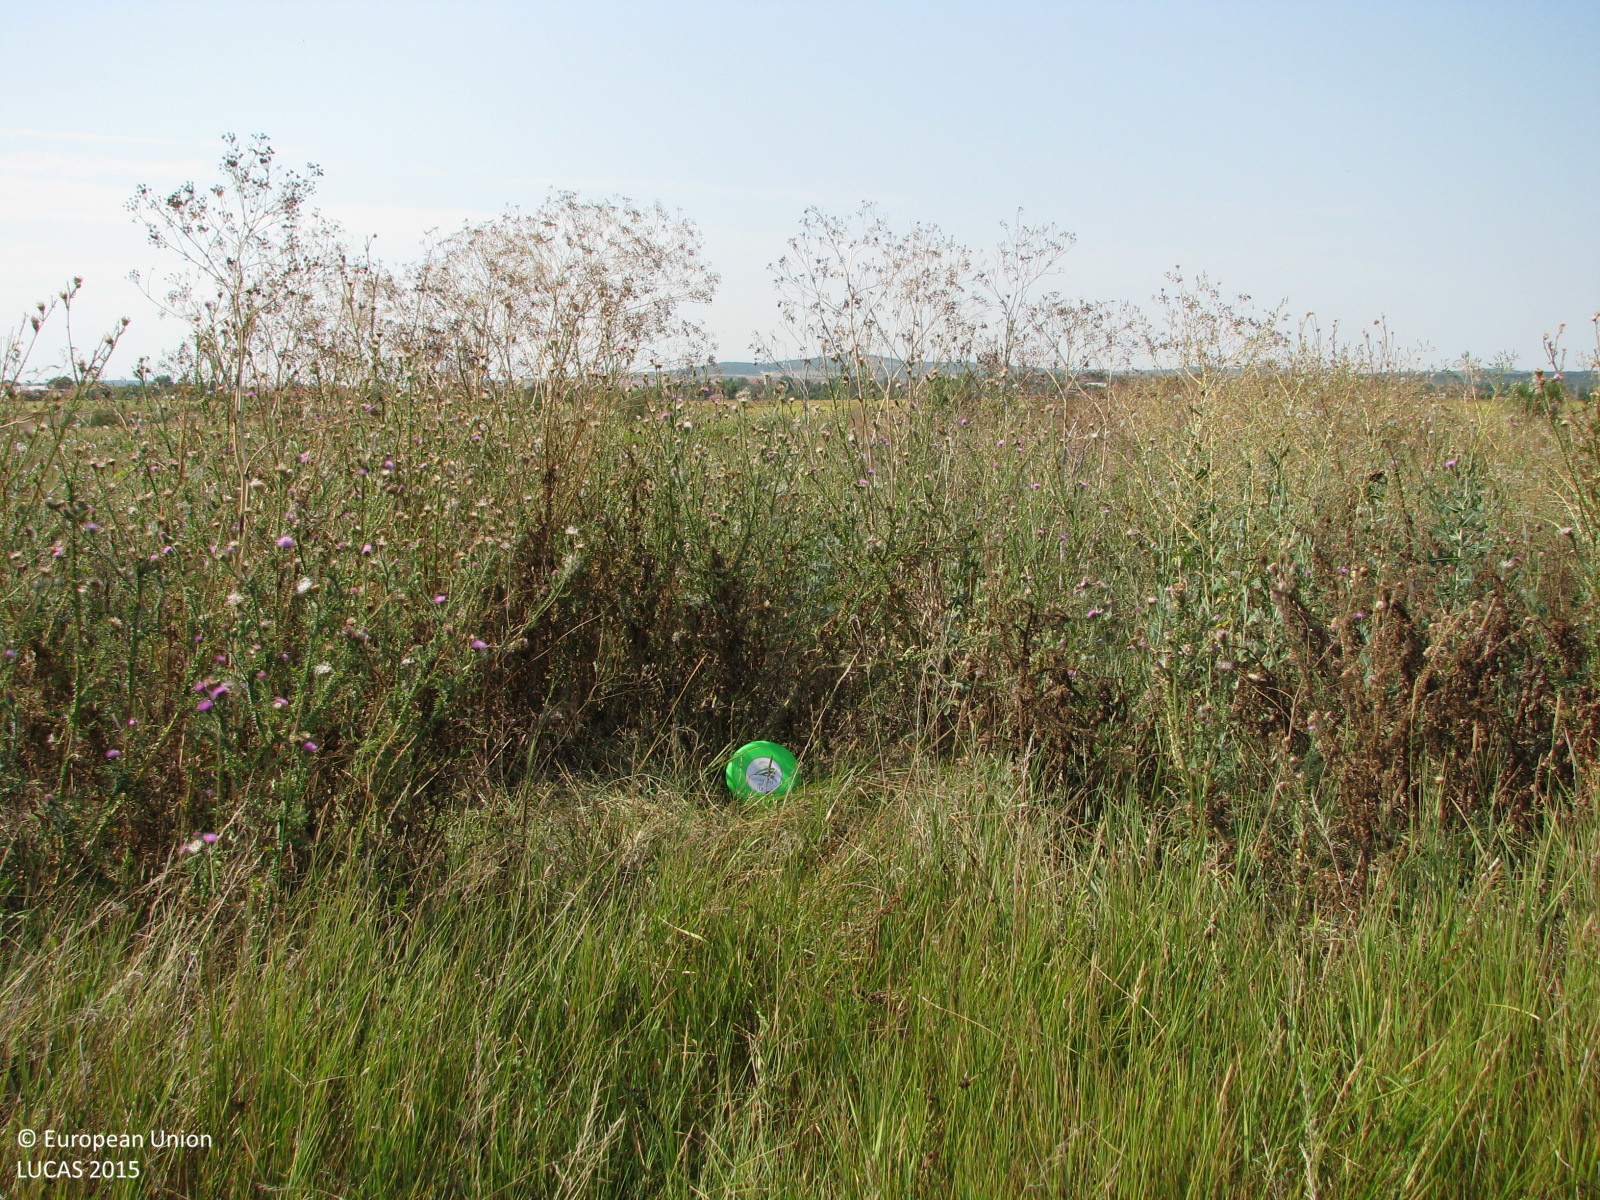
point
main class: Grassland
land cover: Grassland with sparse tree/shrub cover
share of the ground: > 75 %
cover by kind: herbaceous plants 95 %, broadleaved forest trees 5 %
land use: Semi-natural and natural areas not in use
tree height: > 5 m
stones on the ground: < 10 %
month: August
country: BG
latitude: 42.4067
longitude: 26.3075
